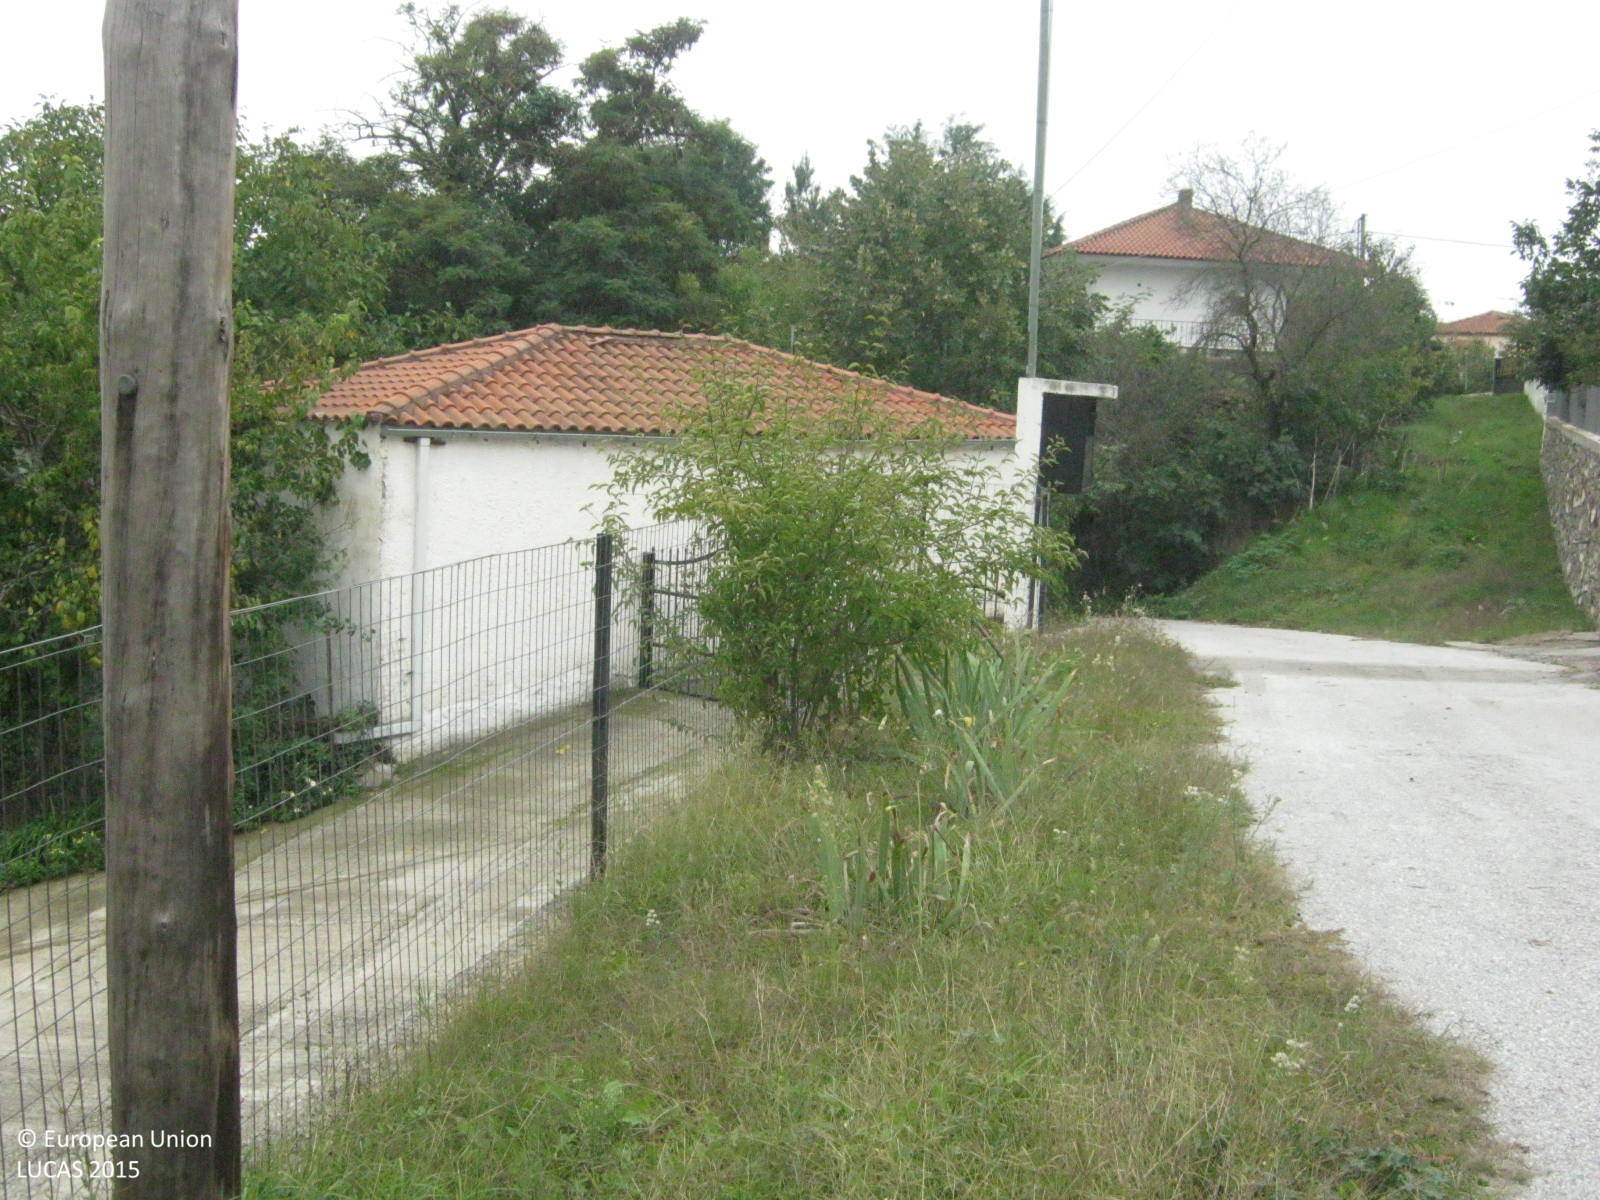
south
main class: Woodland
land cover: Broadleaved woodland
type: thermophilous deciduous forest
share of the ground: > 75 %
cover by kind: broadleaved forest trees 75 %, herbaceous plants 10 %, unconsolidated bare surface 10 %, shrubs 5 %
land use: Semi-natural and natural areas not in use
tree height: > 5 m
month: October
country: GR
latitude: 41.0720
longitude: 23.0696
